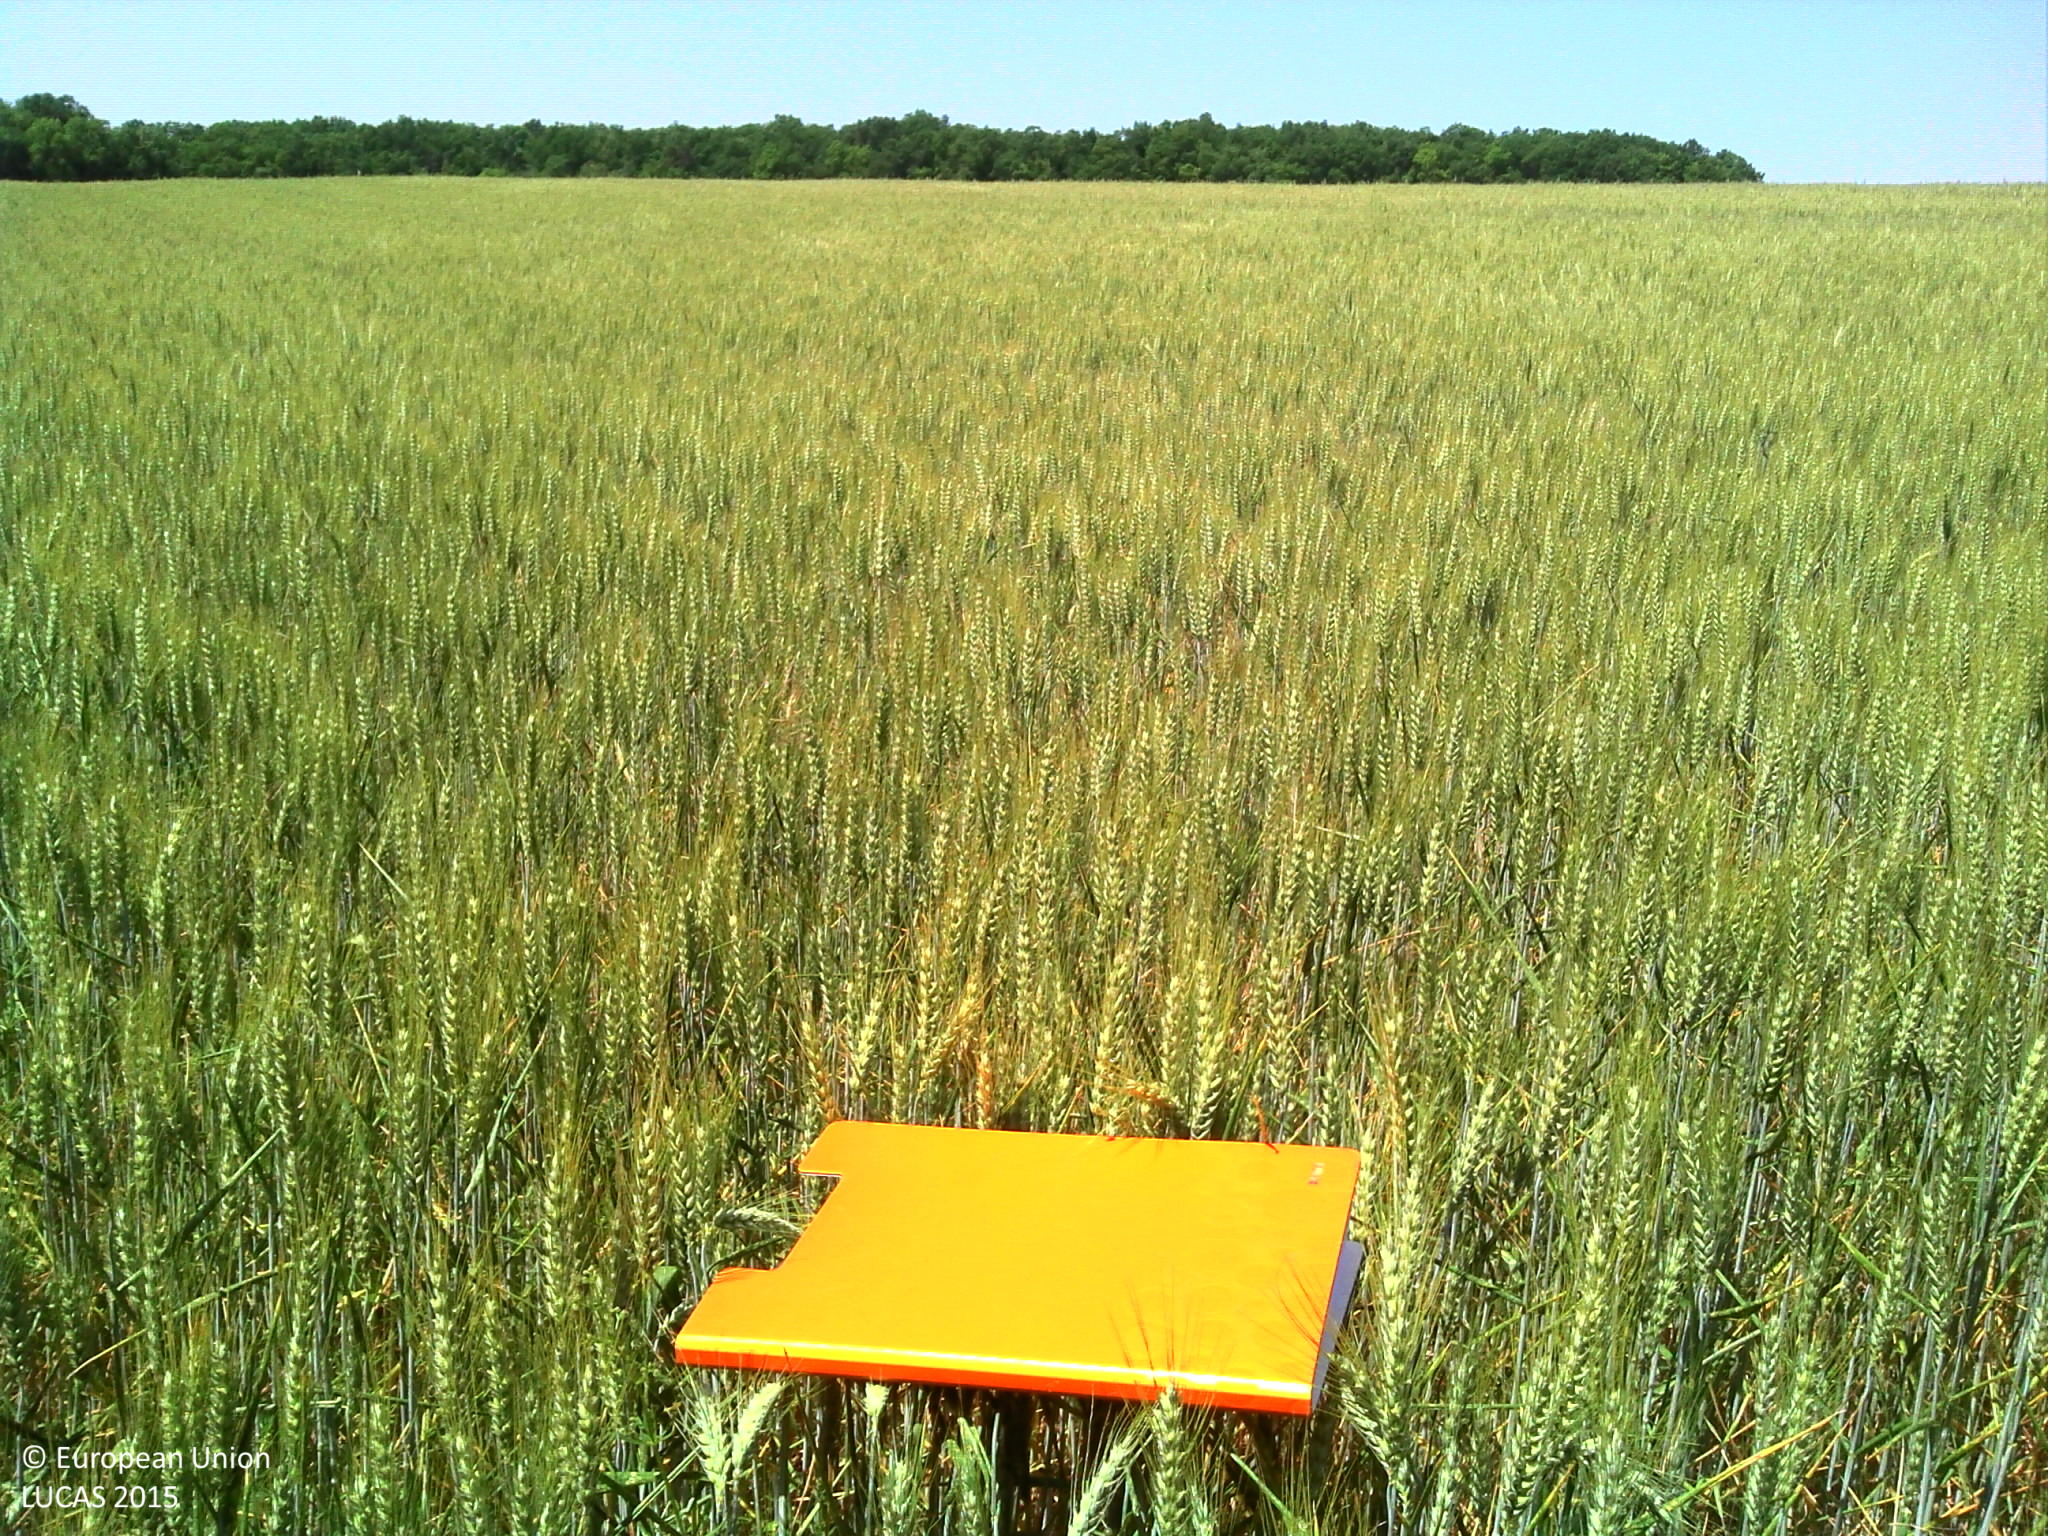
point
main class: Cropland
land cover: Common wheat
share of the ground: > 75 %
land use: Agriculture (excluding fallow land and kitchen gardens)
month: June
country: FR
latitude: 47.0410
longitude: 2.6898
